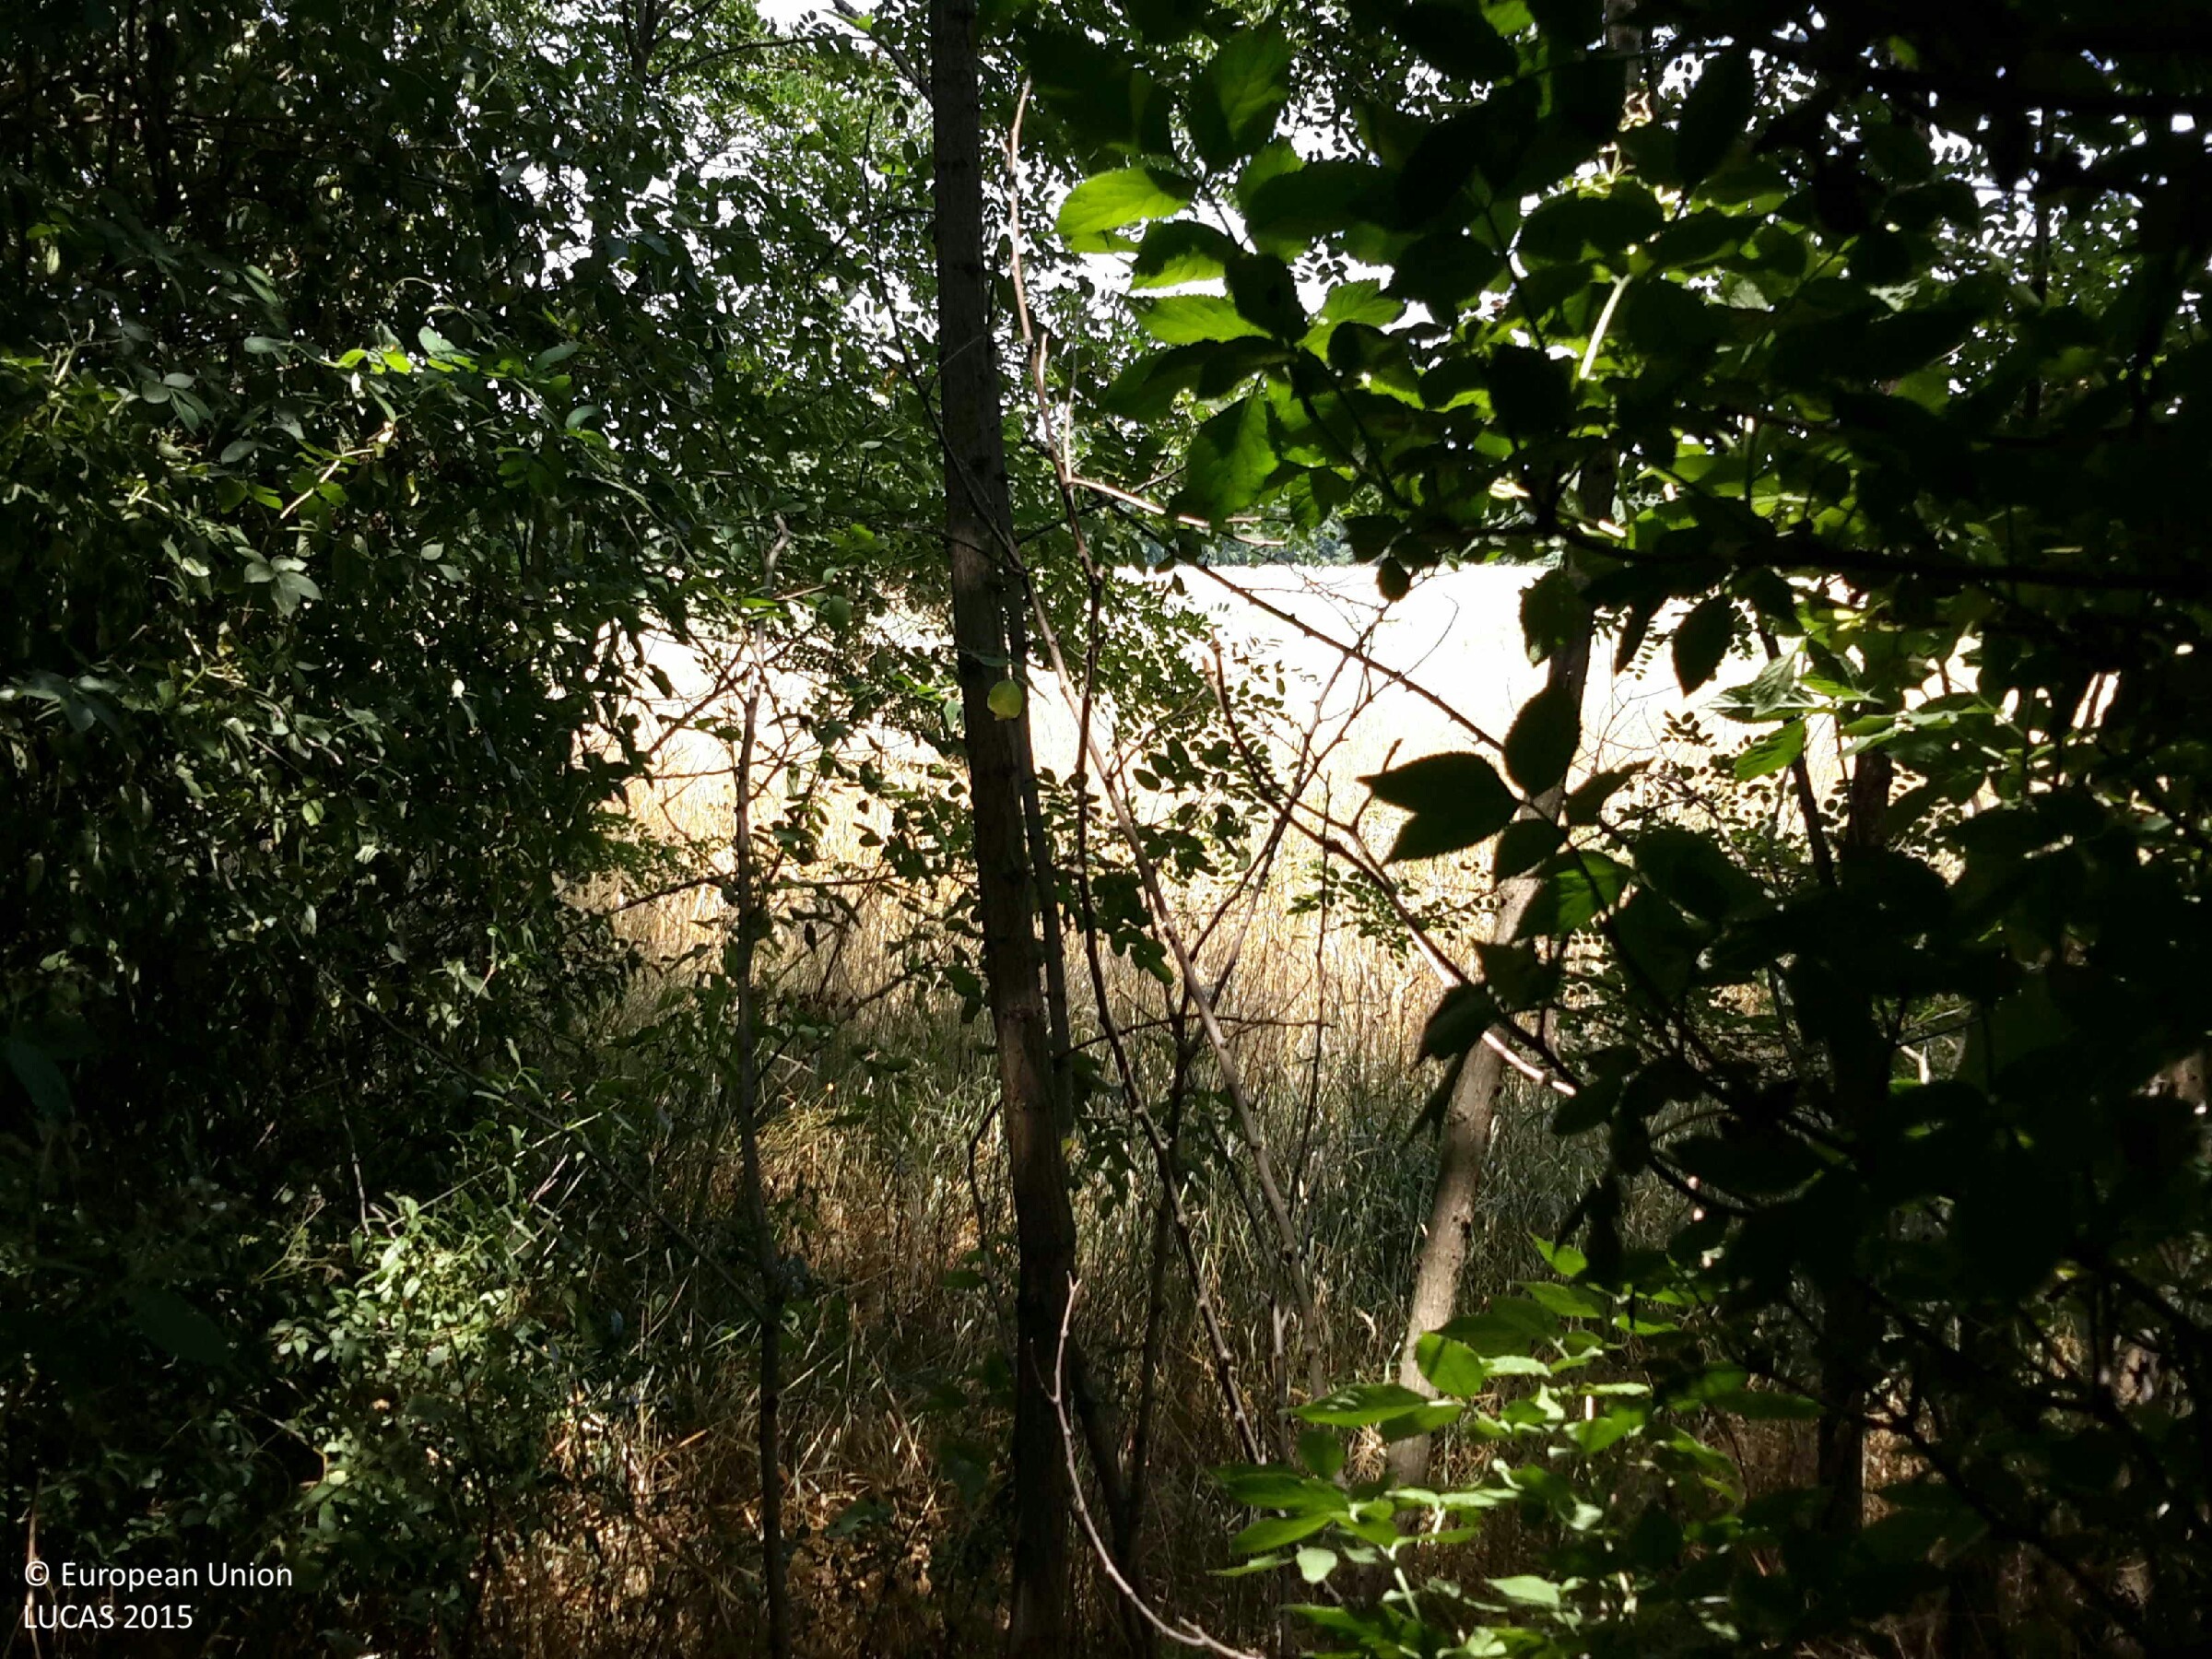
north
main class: Woodland
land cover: Broadleaved woodland
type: thermophilous deciduous forest
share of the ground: > 75 %
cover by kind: broadleaved forest trees 90 %, herbaceous plants 10 %
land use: Forestry
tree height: > 5 m
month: July
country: HU
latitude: 47.6225
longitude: 16.6978
